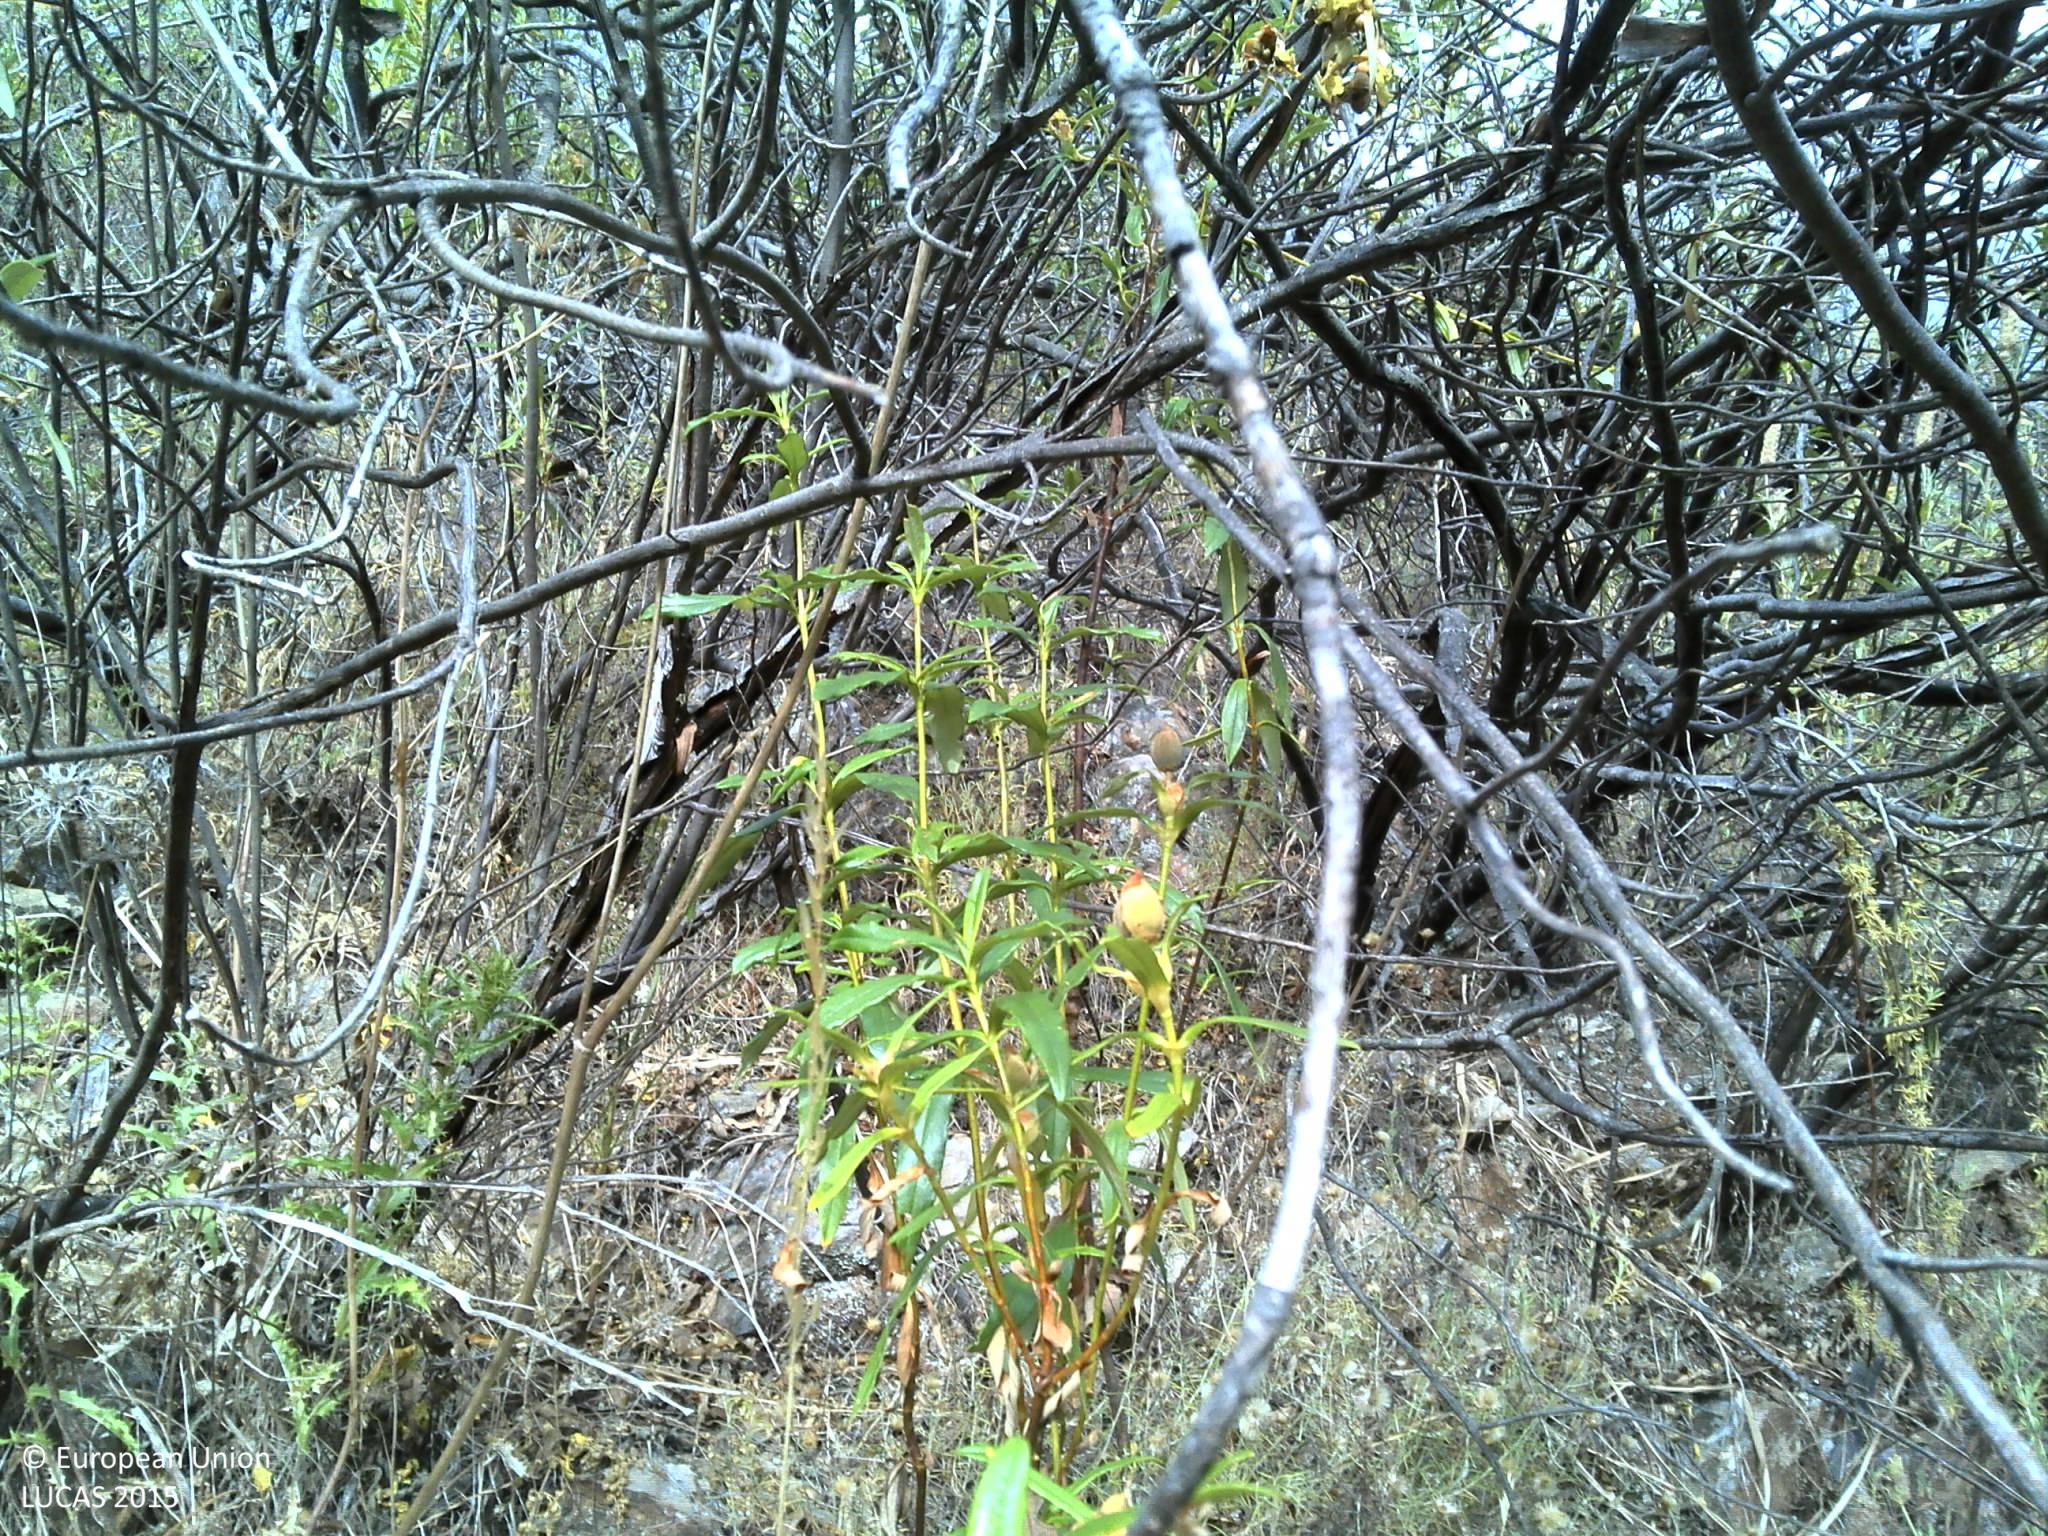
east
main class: Shrubland
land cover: Shrubland without tree cover
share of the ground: > 75 %
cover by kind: shrubs 100 %
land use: Abandoned areas
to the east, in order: Shrubland without tree cover; Tracks; Shrubland without tree cover; Broadleaved woodland; Shrubland without tree cover
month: June
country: PT
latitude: 37.2749
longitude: -7.7038
